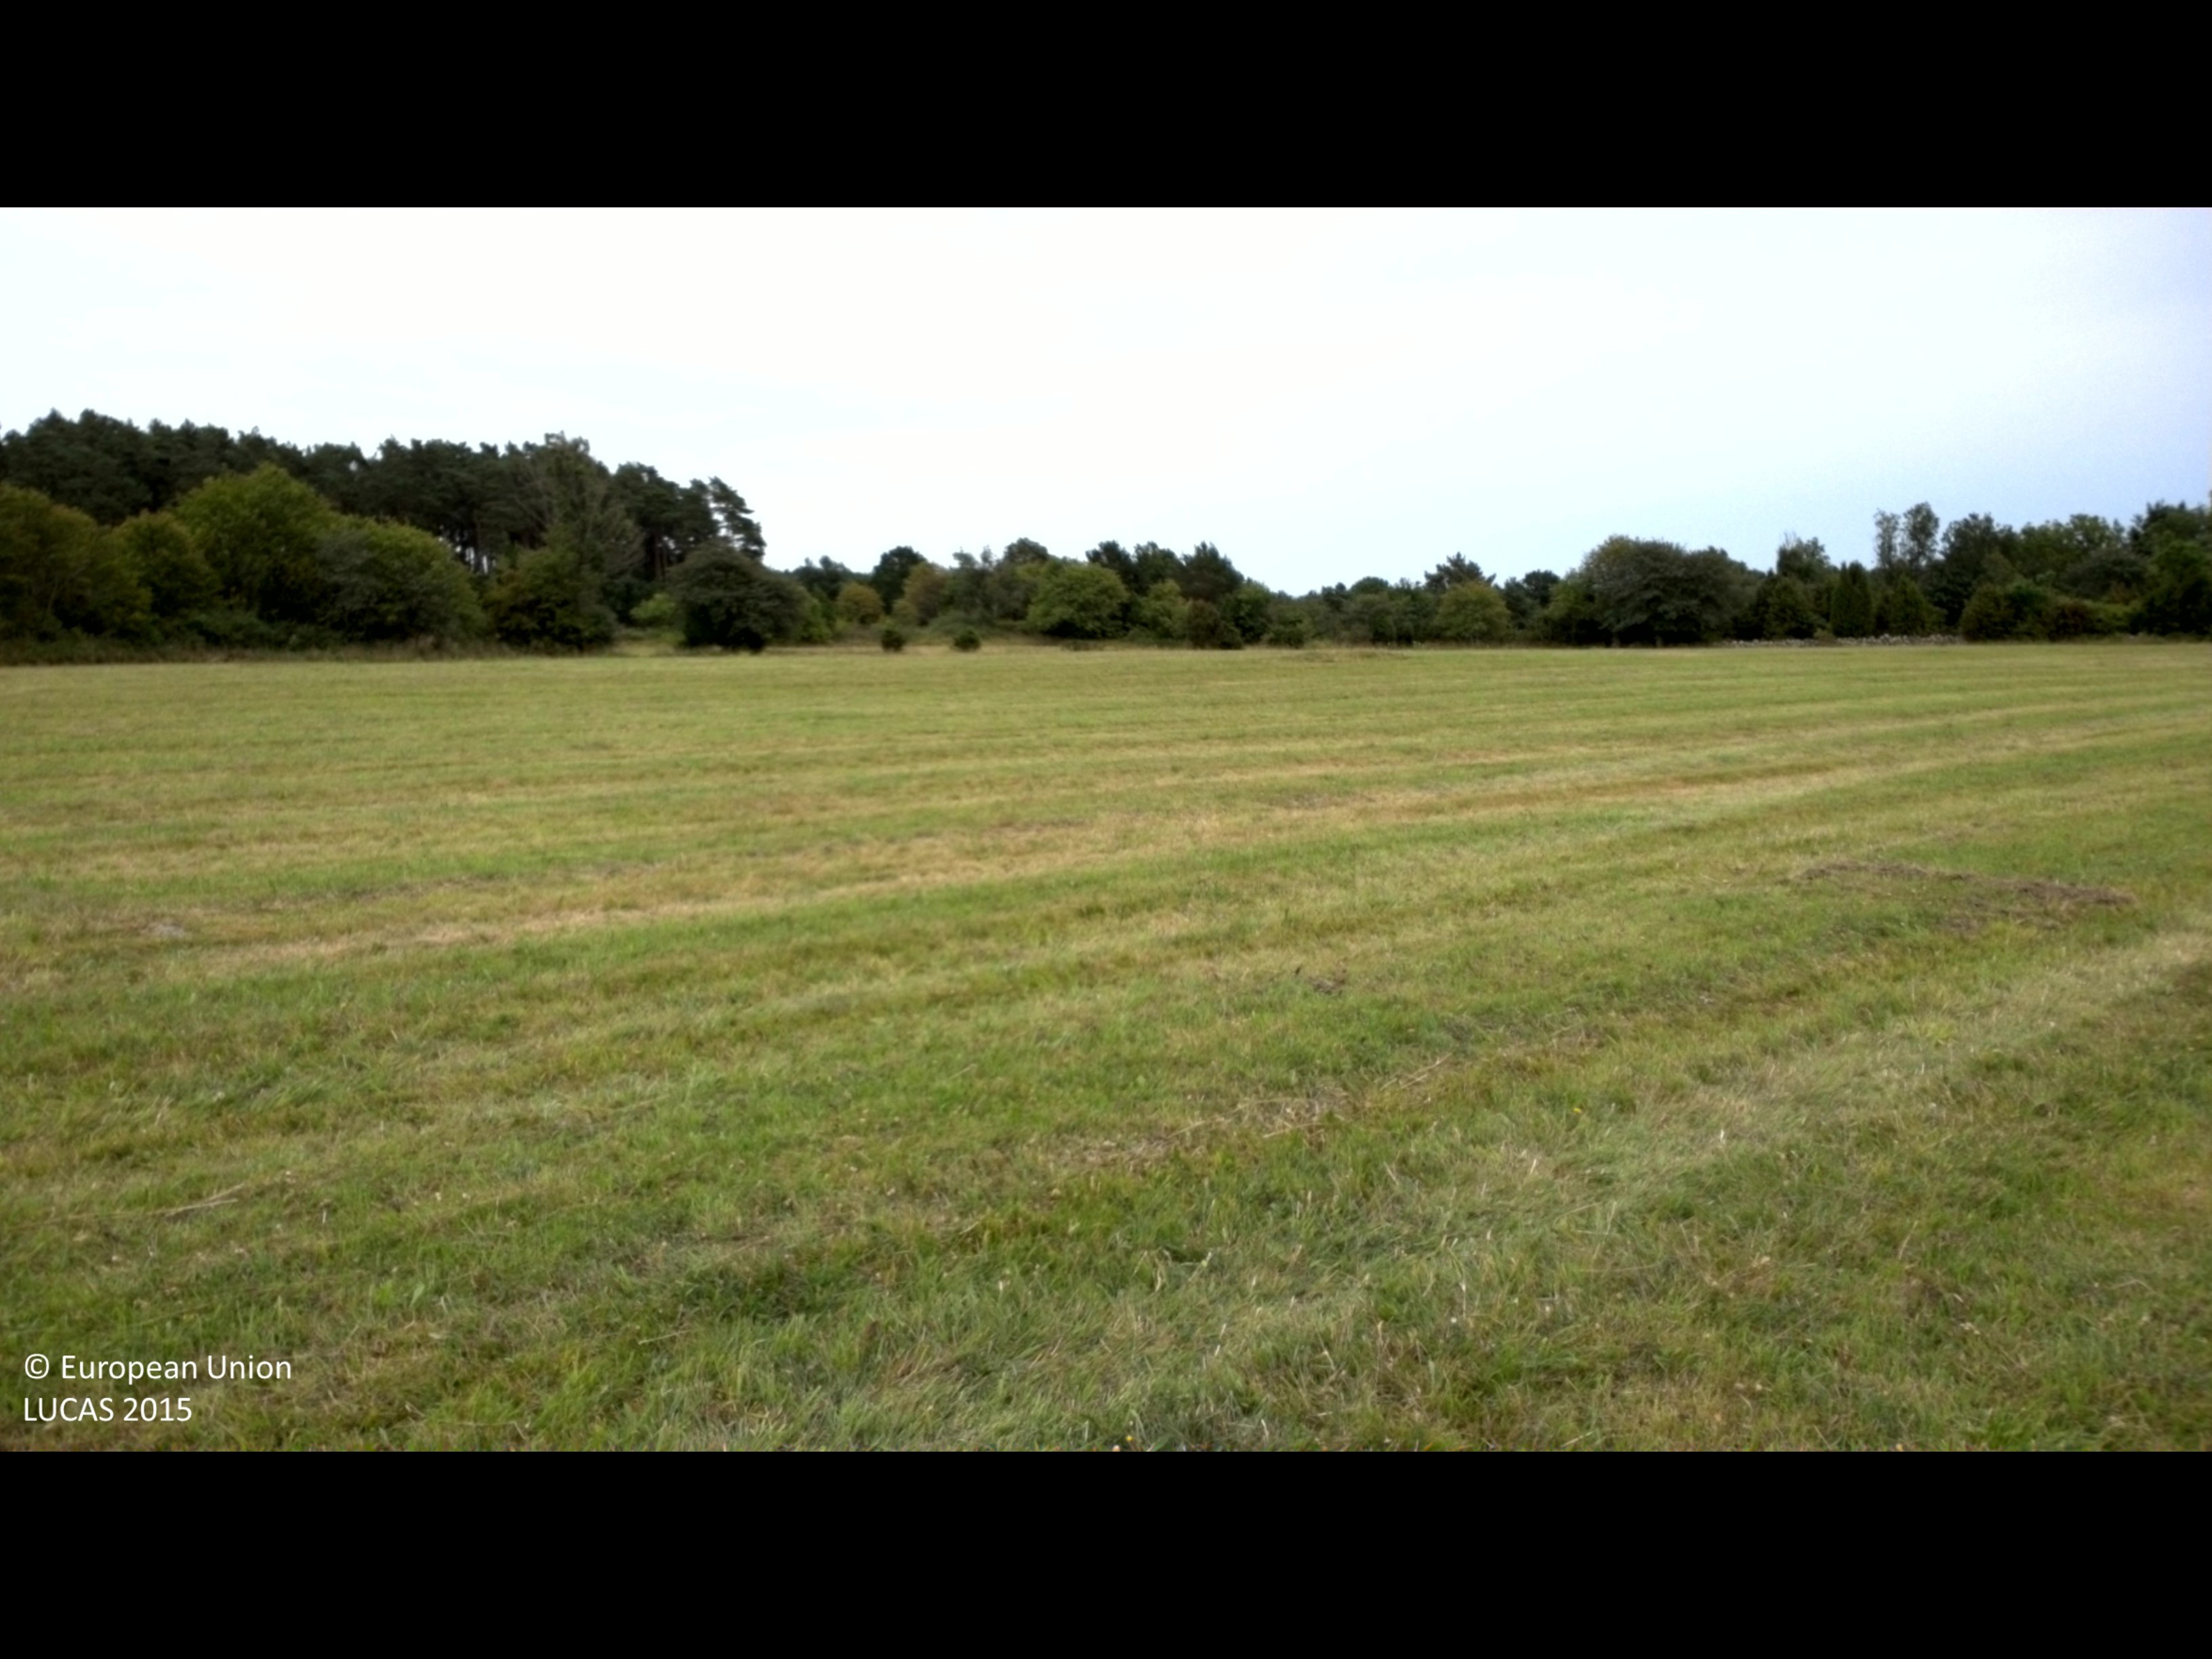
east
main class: Shrubland
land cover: Shrubland without tree cover
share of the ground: > 75 %
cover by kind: shrubs 100 %
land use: Semi-natural and natural areas not in use
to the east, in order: Shrubland without tree cover; Grassland without tree/shrub cover; Abandoned hedges; Dry stone walls; Abandoned hedges; Grassland without tree/shrub cover; Fences; Dry stone walls; Shrubland with sparse tree cover
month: July
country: SE
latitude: 57.1167
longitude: 16.9876
